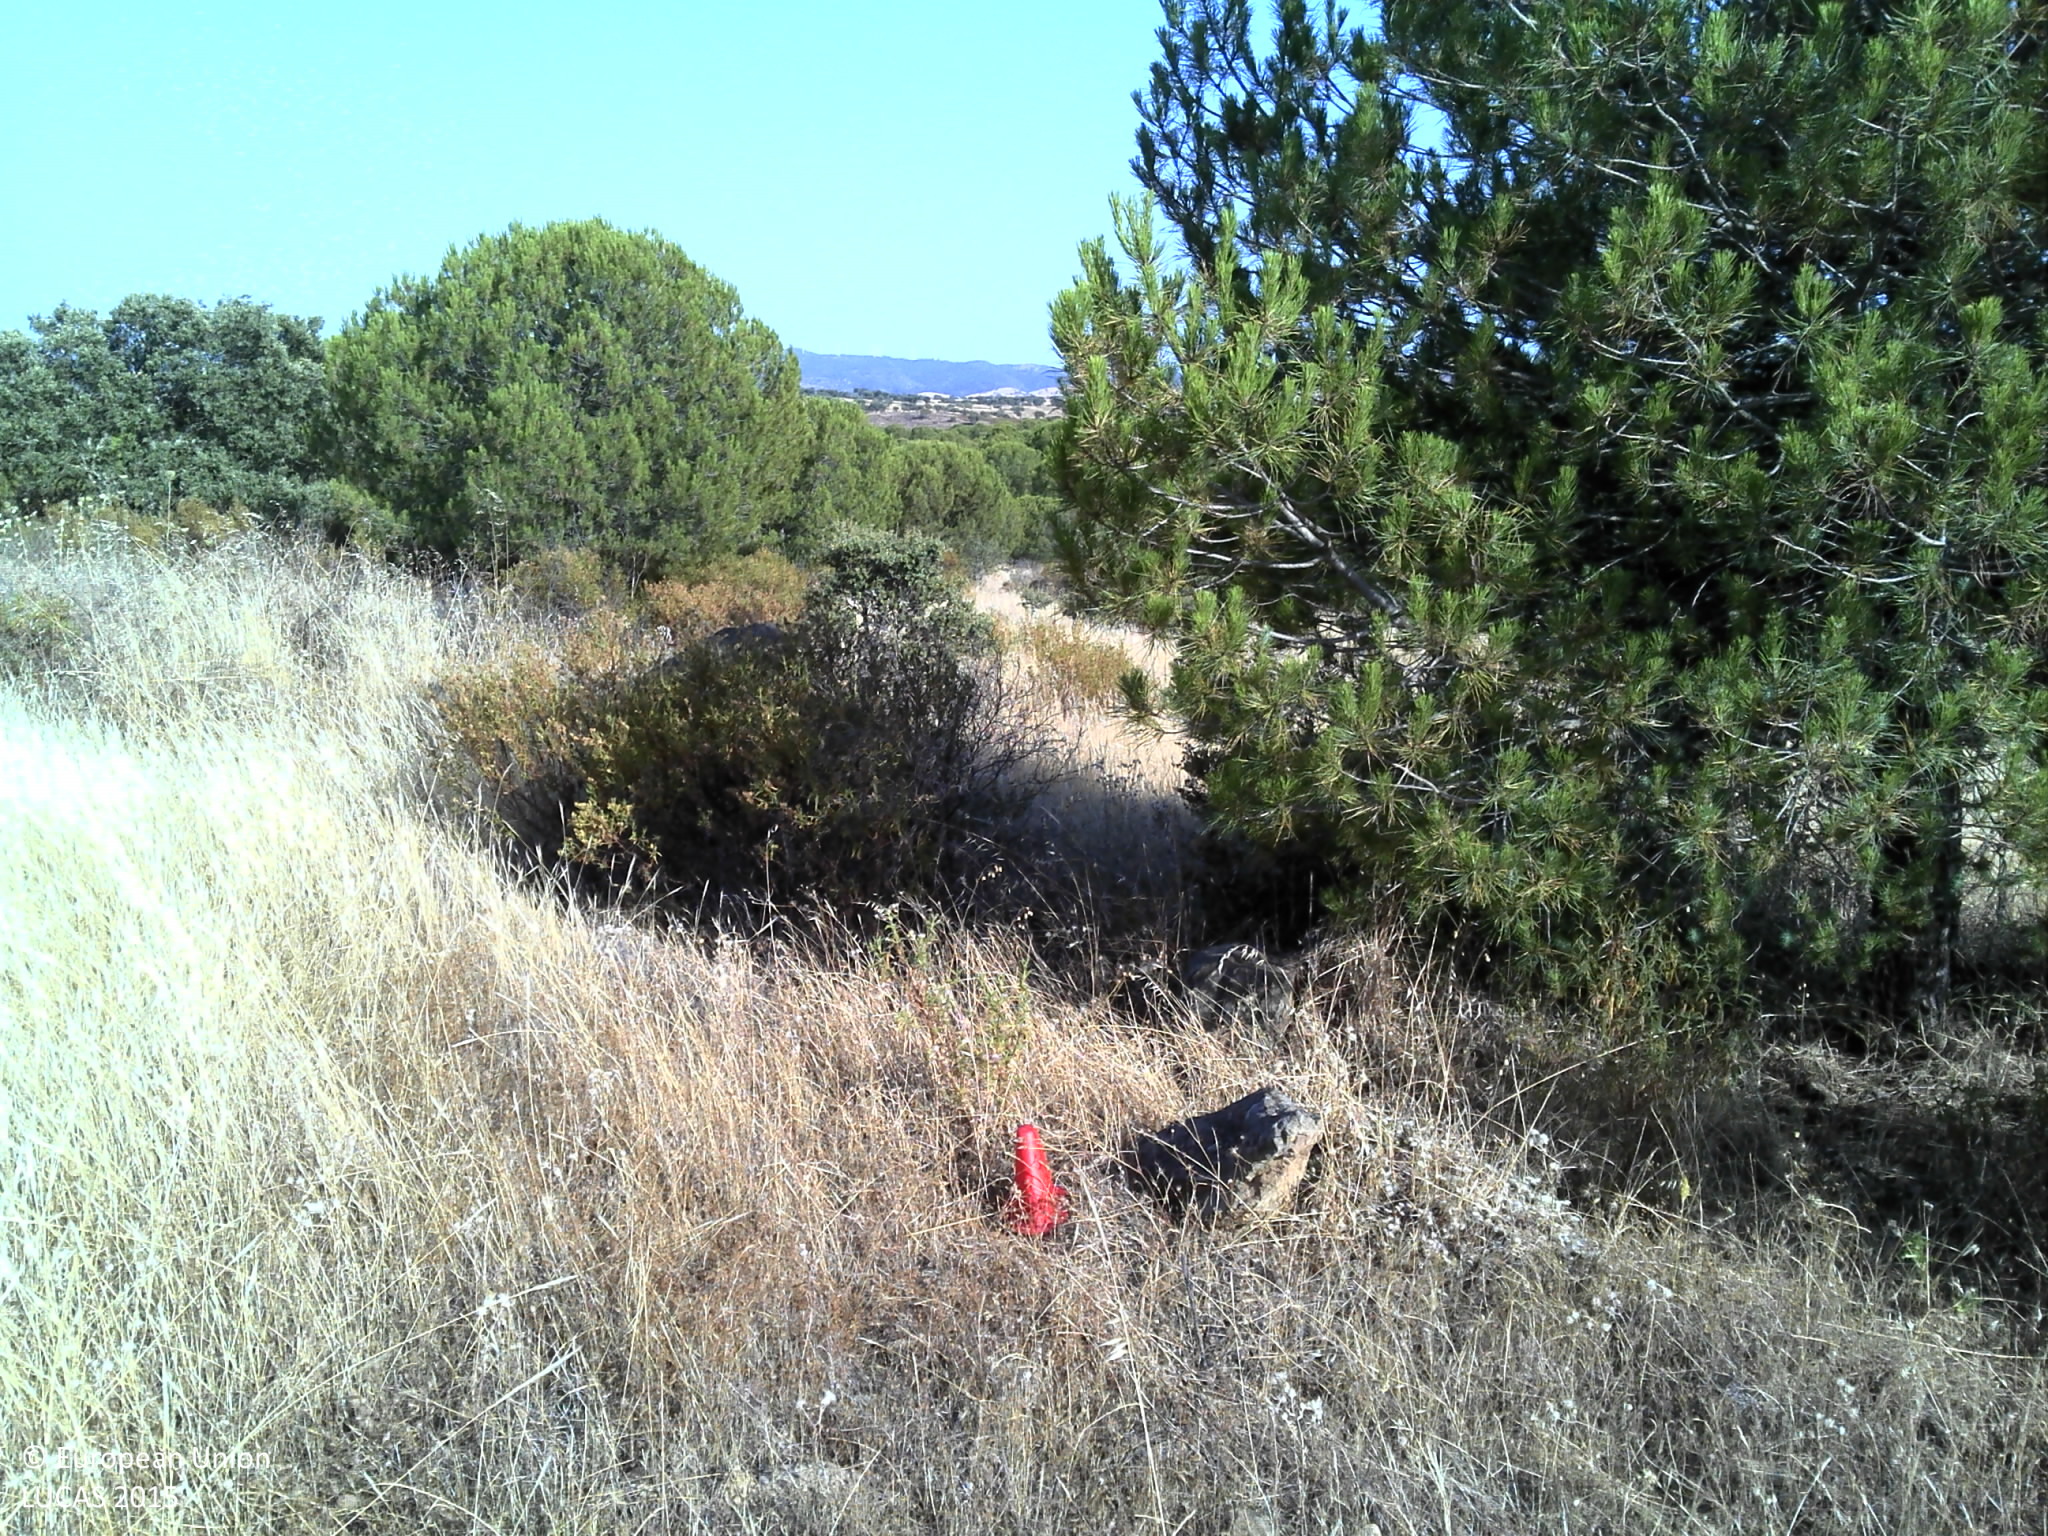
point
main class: Woodland
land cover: Pine dominated coniferous woodland
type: coniferous forest of the mediterranean region
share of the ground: 10 - 25 %
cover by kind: herbaceous plants 65 %, coniferous forest trees 25 %, broadleaved forest trees 5 %, shrubs 5 %
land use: Forestry
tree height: < 5 m
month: June
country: PT
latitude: 37.6160
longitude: -7.5617
